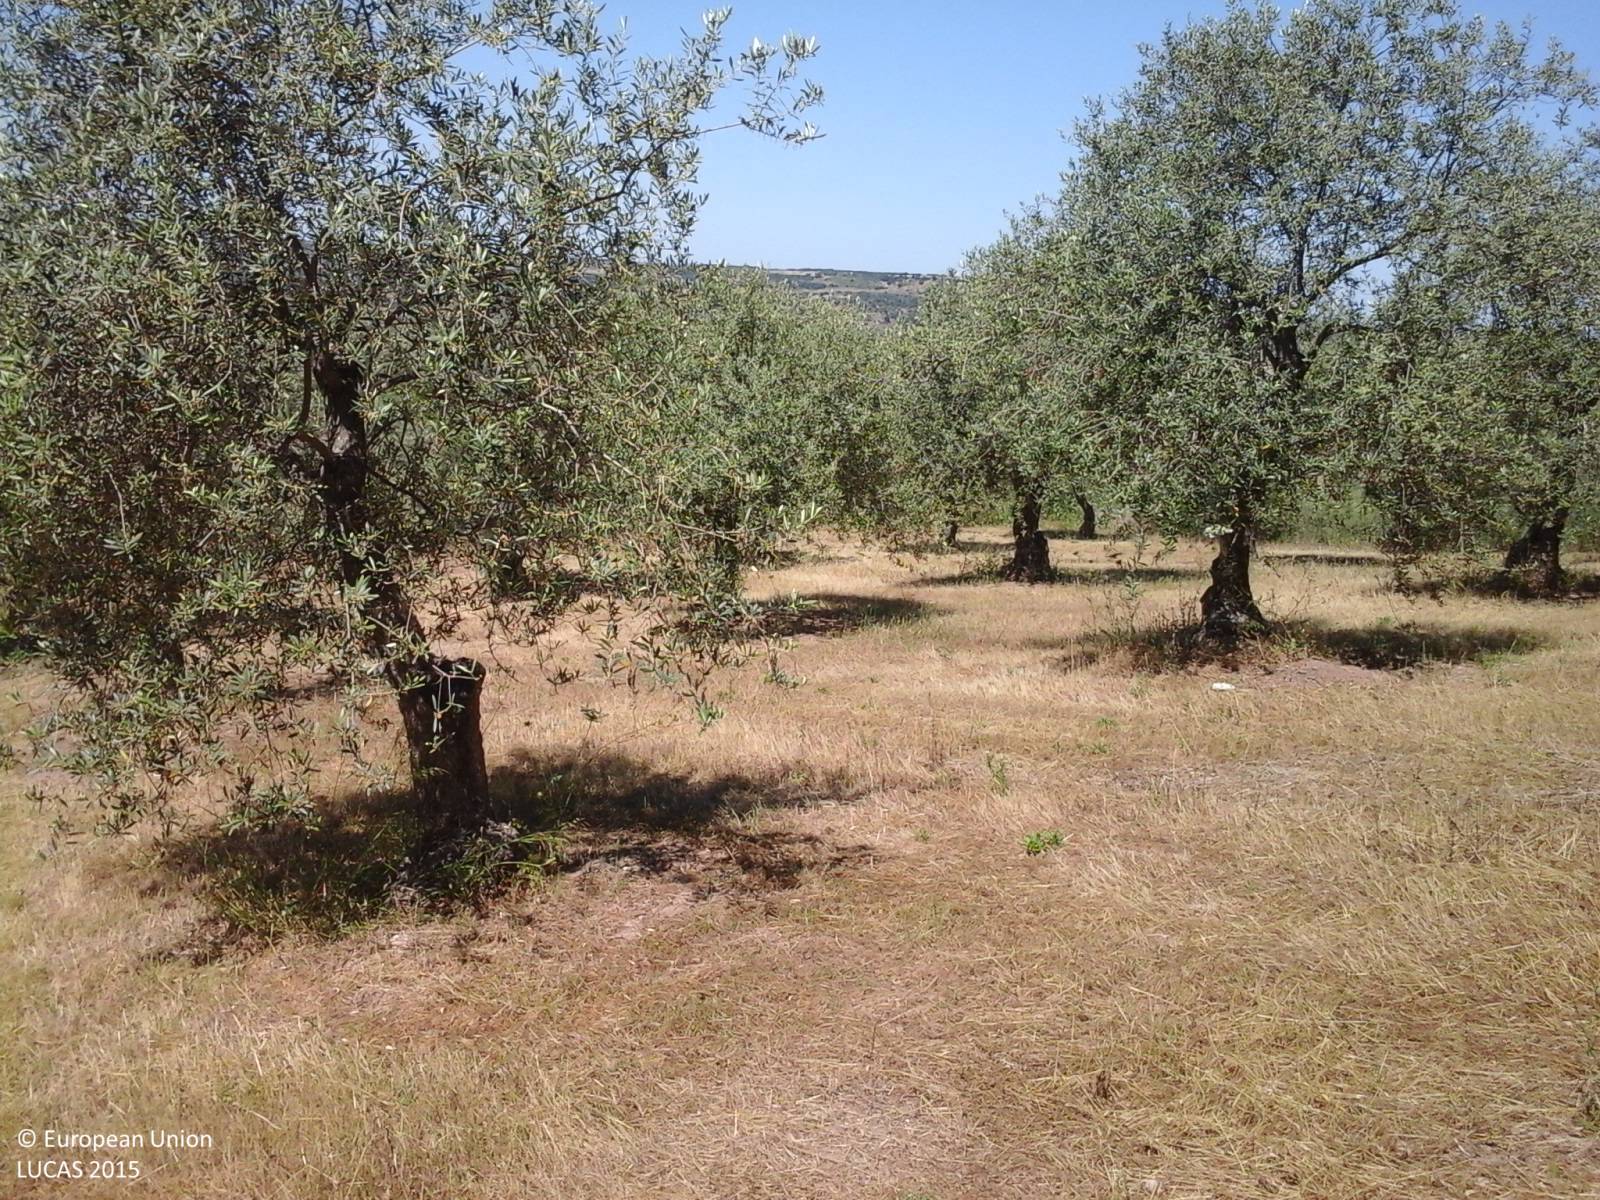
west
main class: Cropland
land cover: Olive groves
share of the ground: 25 - 50 %
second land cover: Spontaneously vegetated surfaces
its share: 50 - 75 %
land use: Agriculture (excluding fallow land and kitchen gardens)
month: May
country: IT
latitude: 40.6538
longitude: 8.4817
